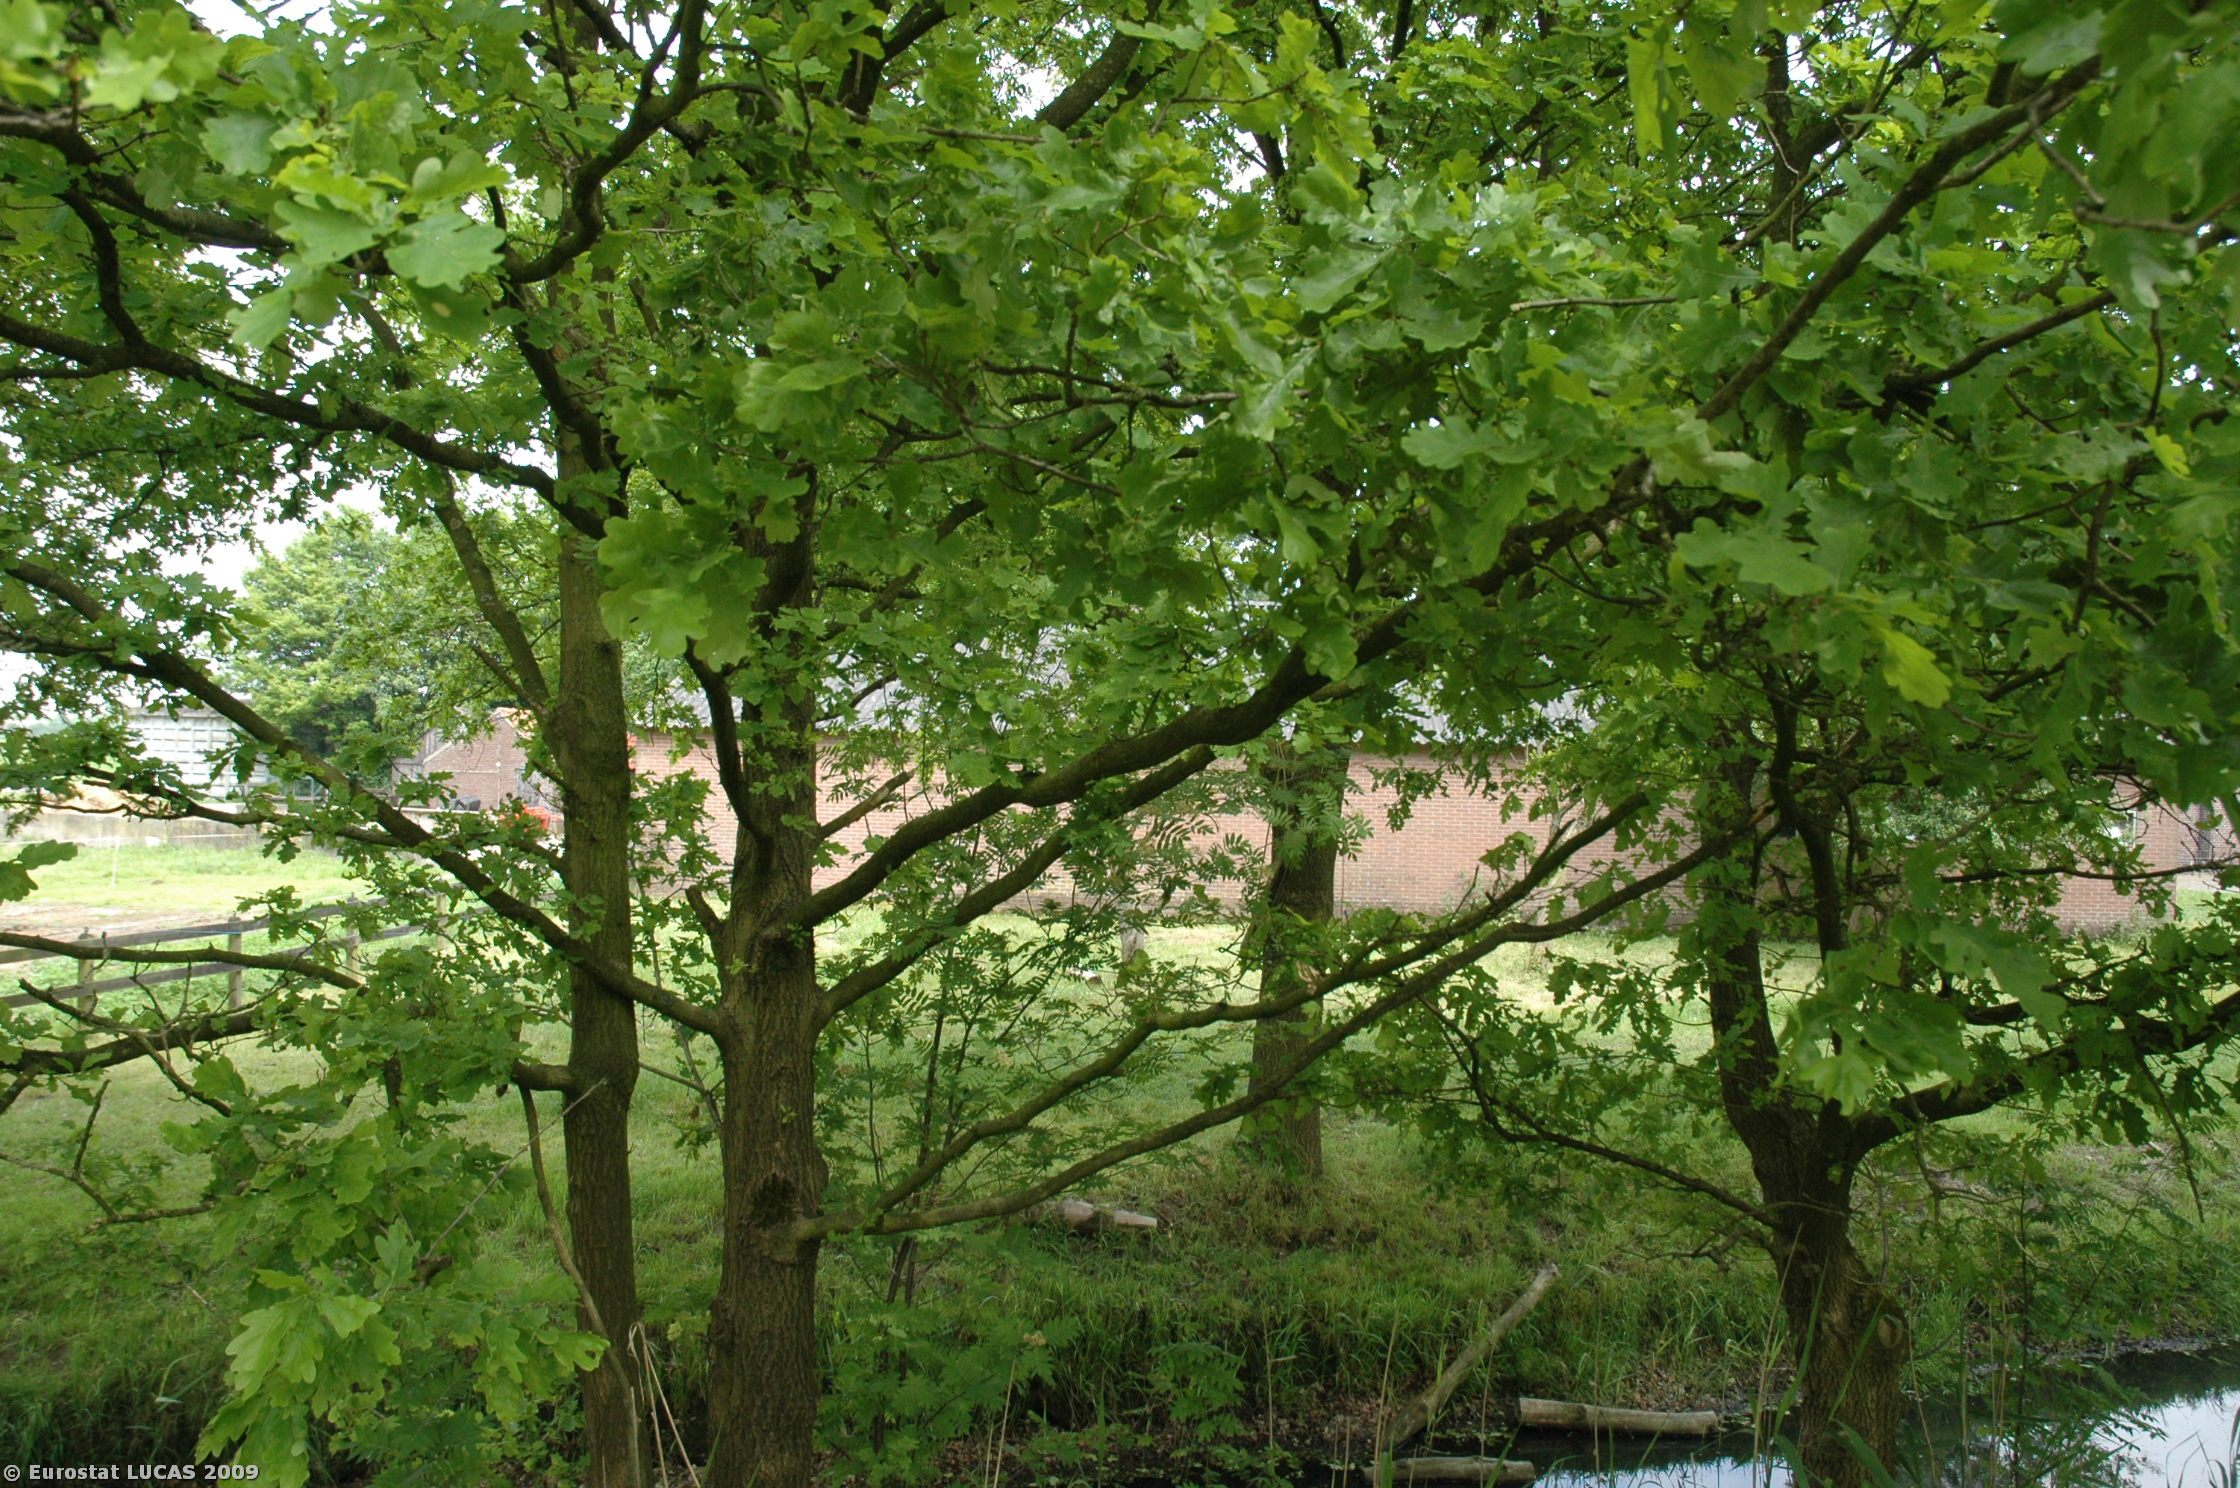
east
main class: Grassland
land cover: Grassland without tree/shrub cover
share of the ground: > 75 %
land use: Agriculture (excluding fallow land and kitchen gardens)
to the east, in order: Grassland without tree/shrub cover; Fences; Ditches and canals; Fences; Grassland without tree/shrub cover; Fences; Ditches and canals; Fences; Grassland without tree/shrub cover
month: May
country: NL
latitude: 52.1094
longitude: 5.4279
